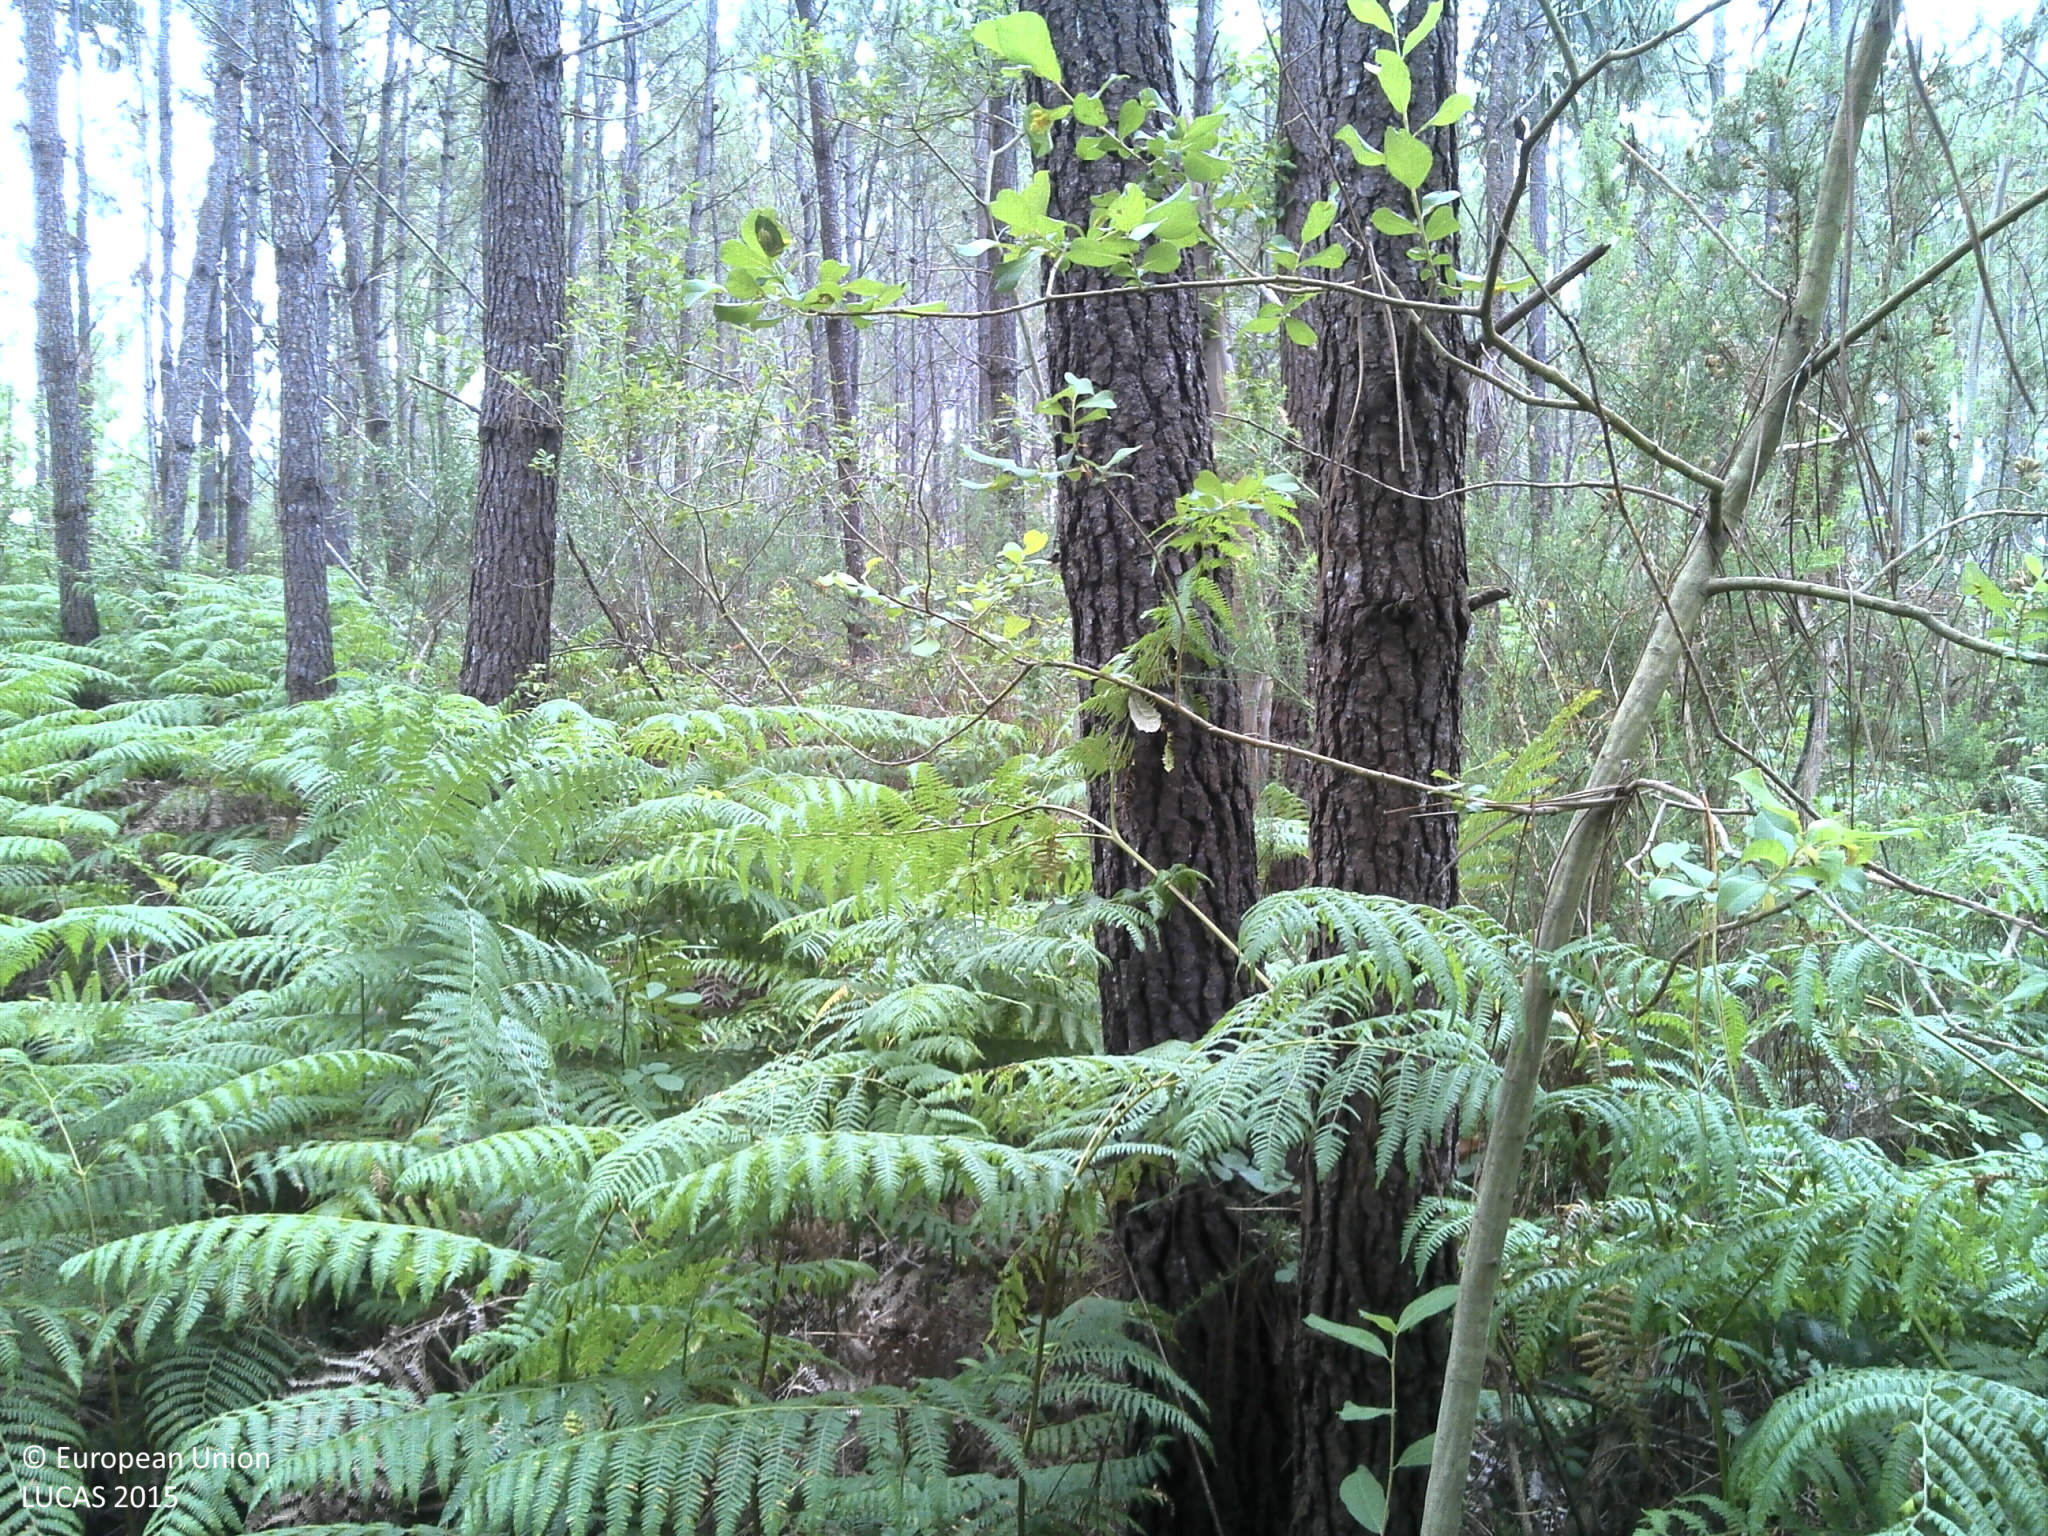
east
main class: Woodland
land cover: Pine dominated coniferous woodland
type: coniferous forest of the mediterranean region
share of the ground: 50 - 75 %
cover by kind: coniferous forest trees 60 %, shrubs 25 %, unconsolidated bare surface 15 %
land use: Forestry
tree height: > 5 m
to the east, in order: Pine dominated coniferous woodland; Shrubland without tree cover; Shrubland with sparse tree cover; Broadleaved woodland; Pine dominated coniferous woodland; Broadleaved woodland
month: June
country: PT
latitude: 40.2682
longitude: -8.6835
